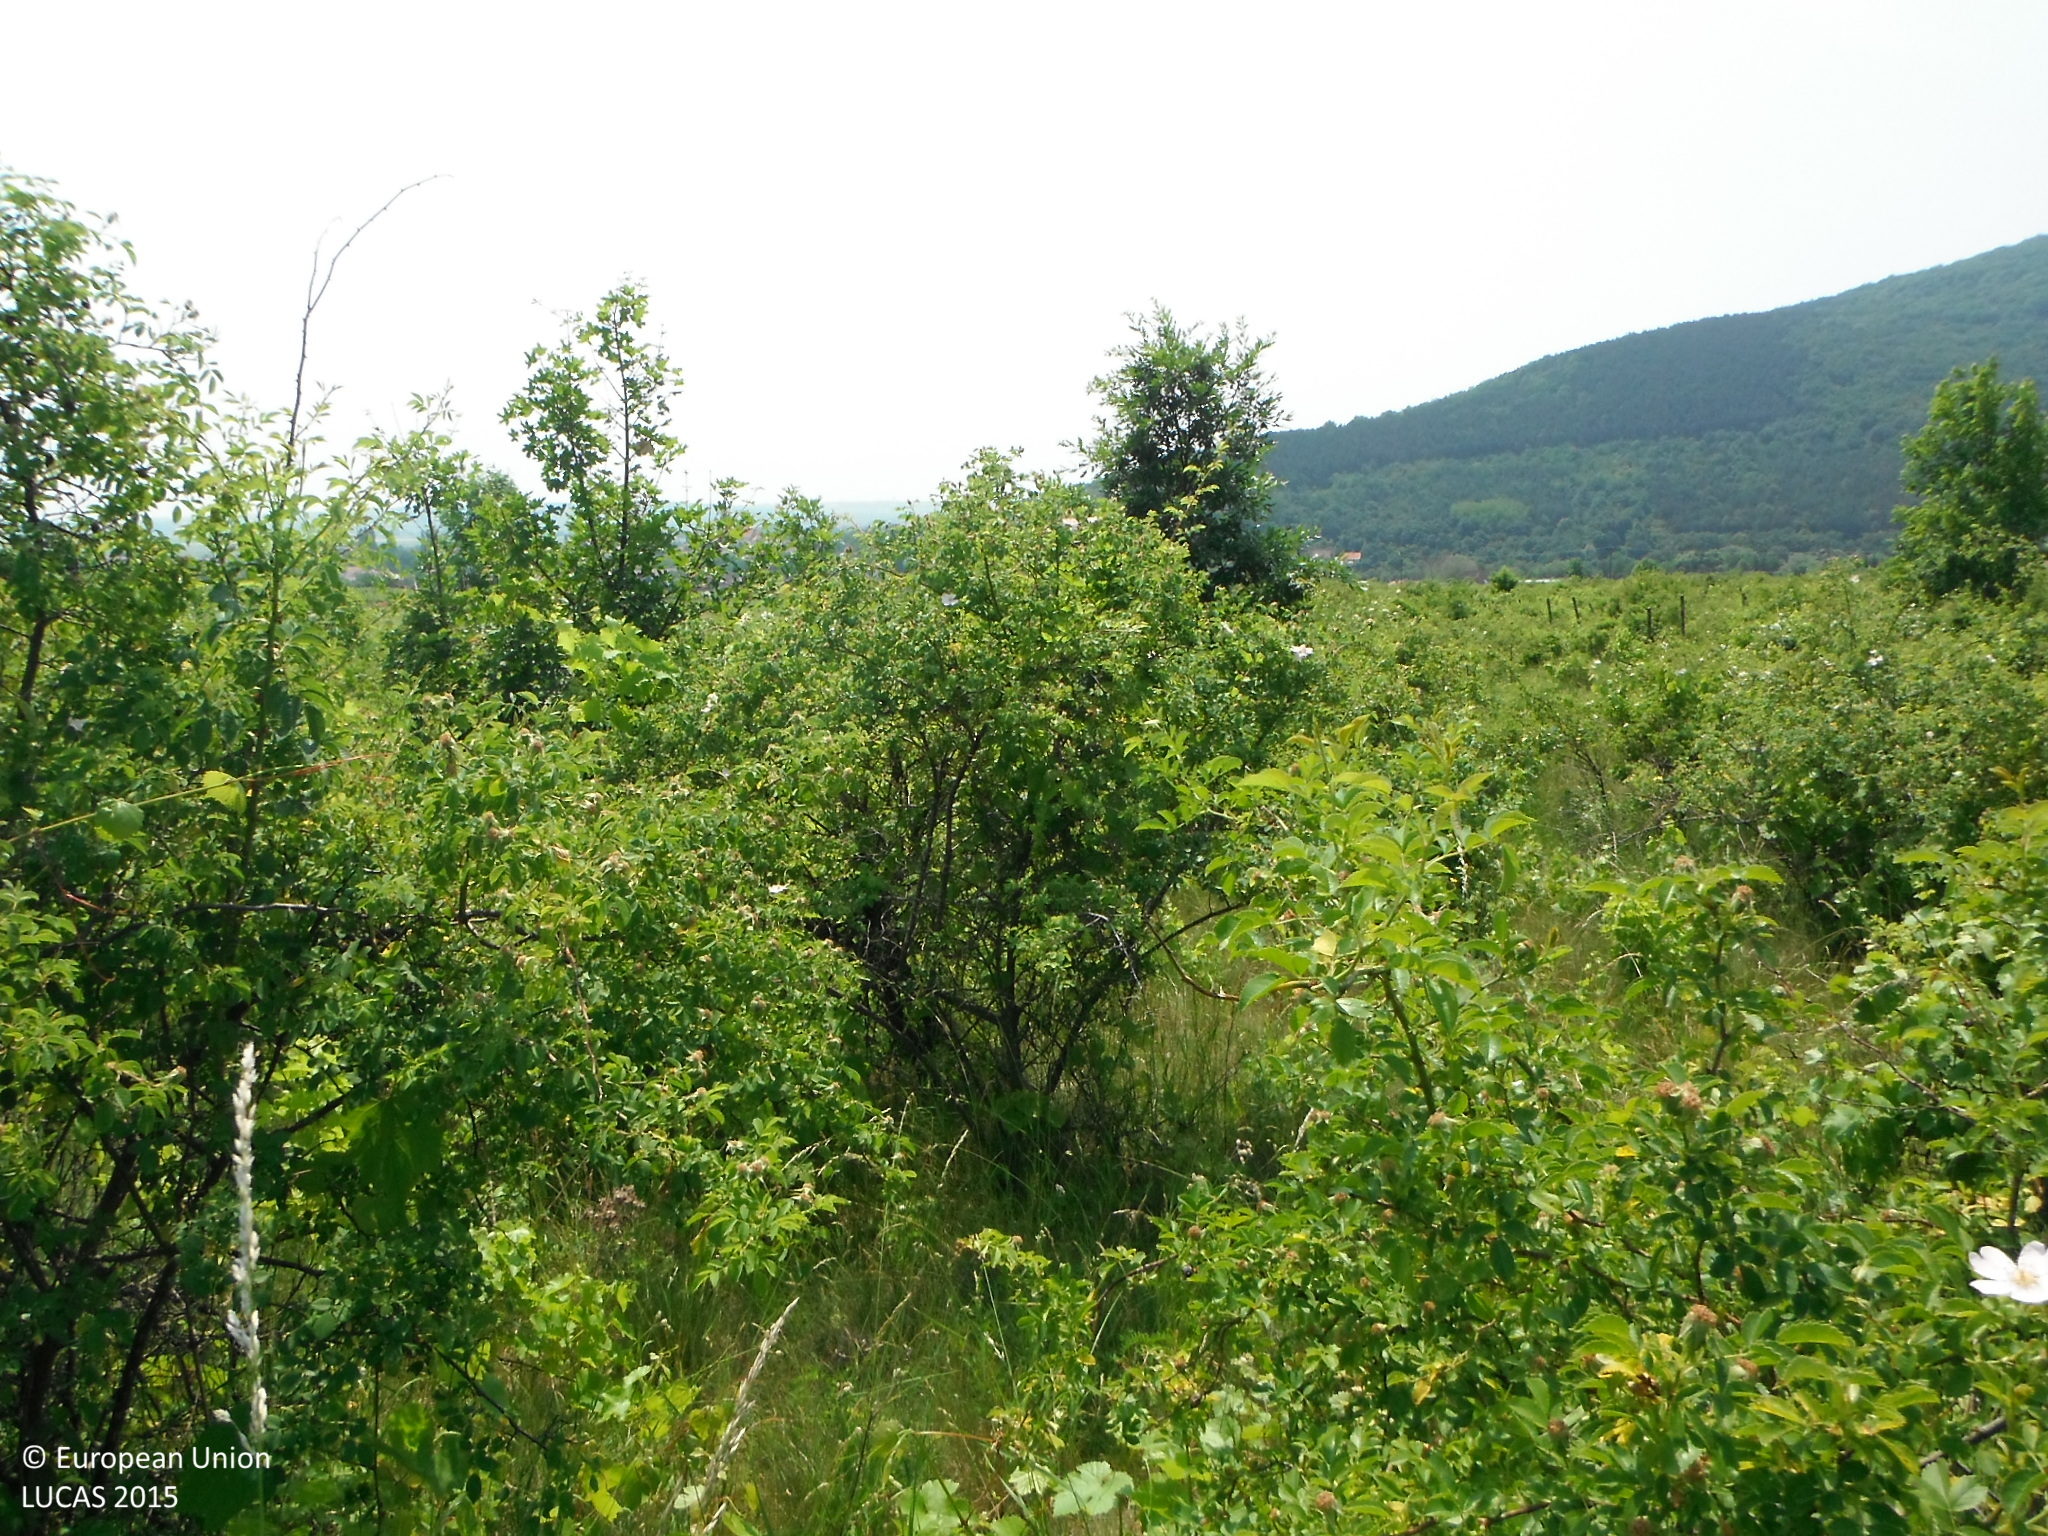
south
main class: Cropland
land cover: Vineyards
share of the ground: 50 - 75 %
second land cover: Shrubland without tree cover
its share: 50 - 75 %
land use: Abandoned areas
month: June
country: SK
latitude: 48.4781
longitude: 17.4371
